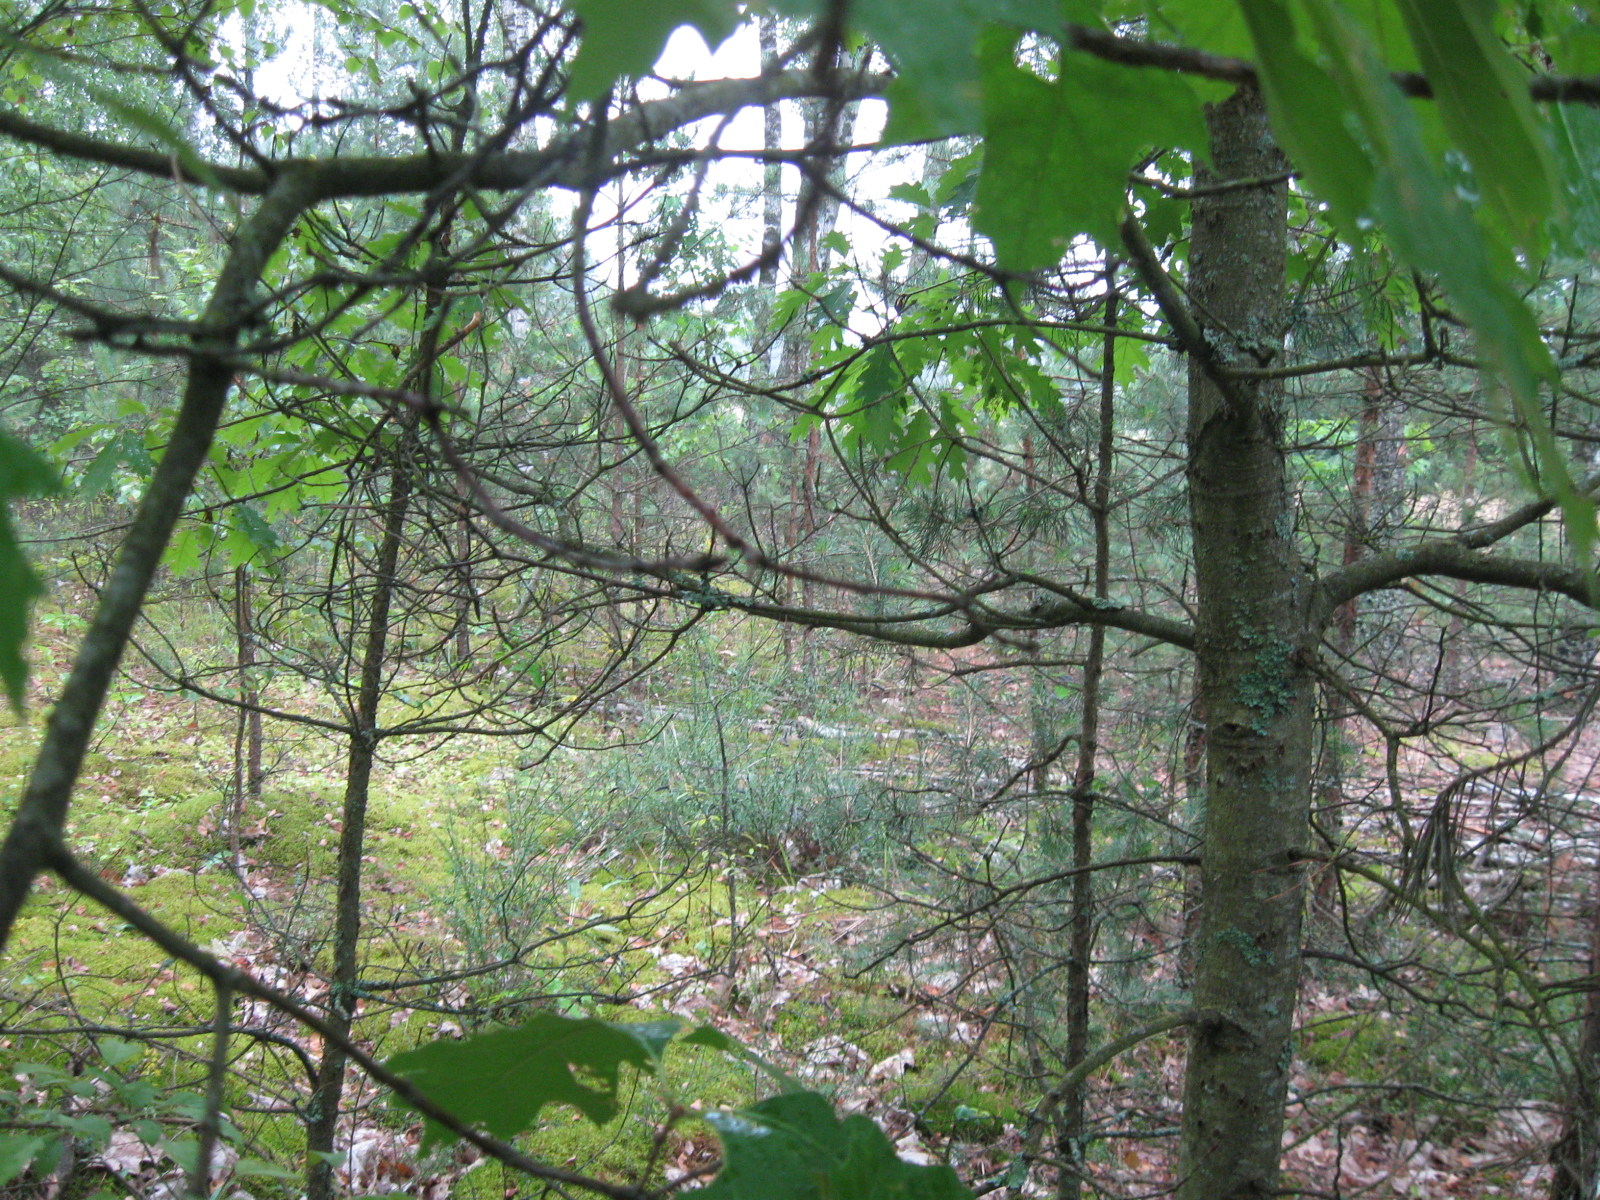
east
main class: Woodland
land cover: Pine dominated mixed woodland
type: hemiboreal forest and nemoral coniferous forest and mixed broadleaved-coniferous forest
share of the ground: > 75 %
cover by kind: coniferous forest trees 50 %, broadleaved forest trees 30 %, herbaceous plants 10 %, shrubs 5 %, lichens and mosses 5 %
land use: Forestry
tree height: > 5 m
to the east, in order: Pine dominated mixed woodland; Other mixed woodland; Grassland without tree/shrub cover; Pine dominated coniferous woodland; Electric lines; Pine dominated coniferous woodland; Grassland with sparse tree/shrub cover; Electric lines; Grassland with sparse tree/shrub cover; Tracks; Grassland without tree/shrub cover
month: July
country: LT
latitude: 53.9934
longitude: 23.6459
